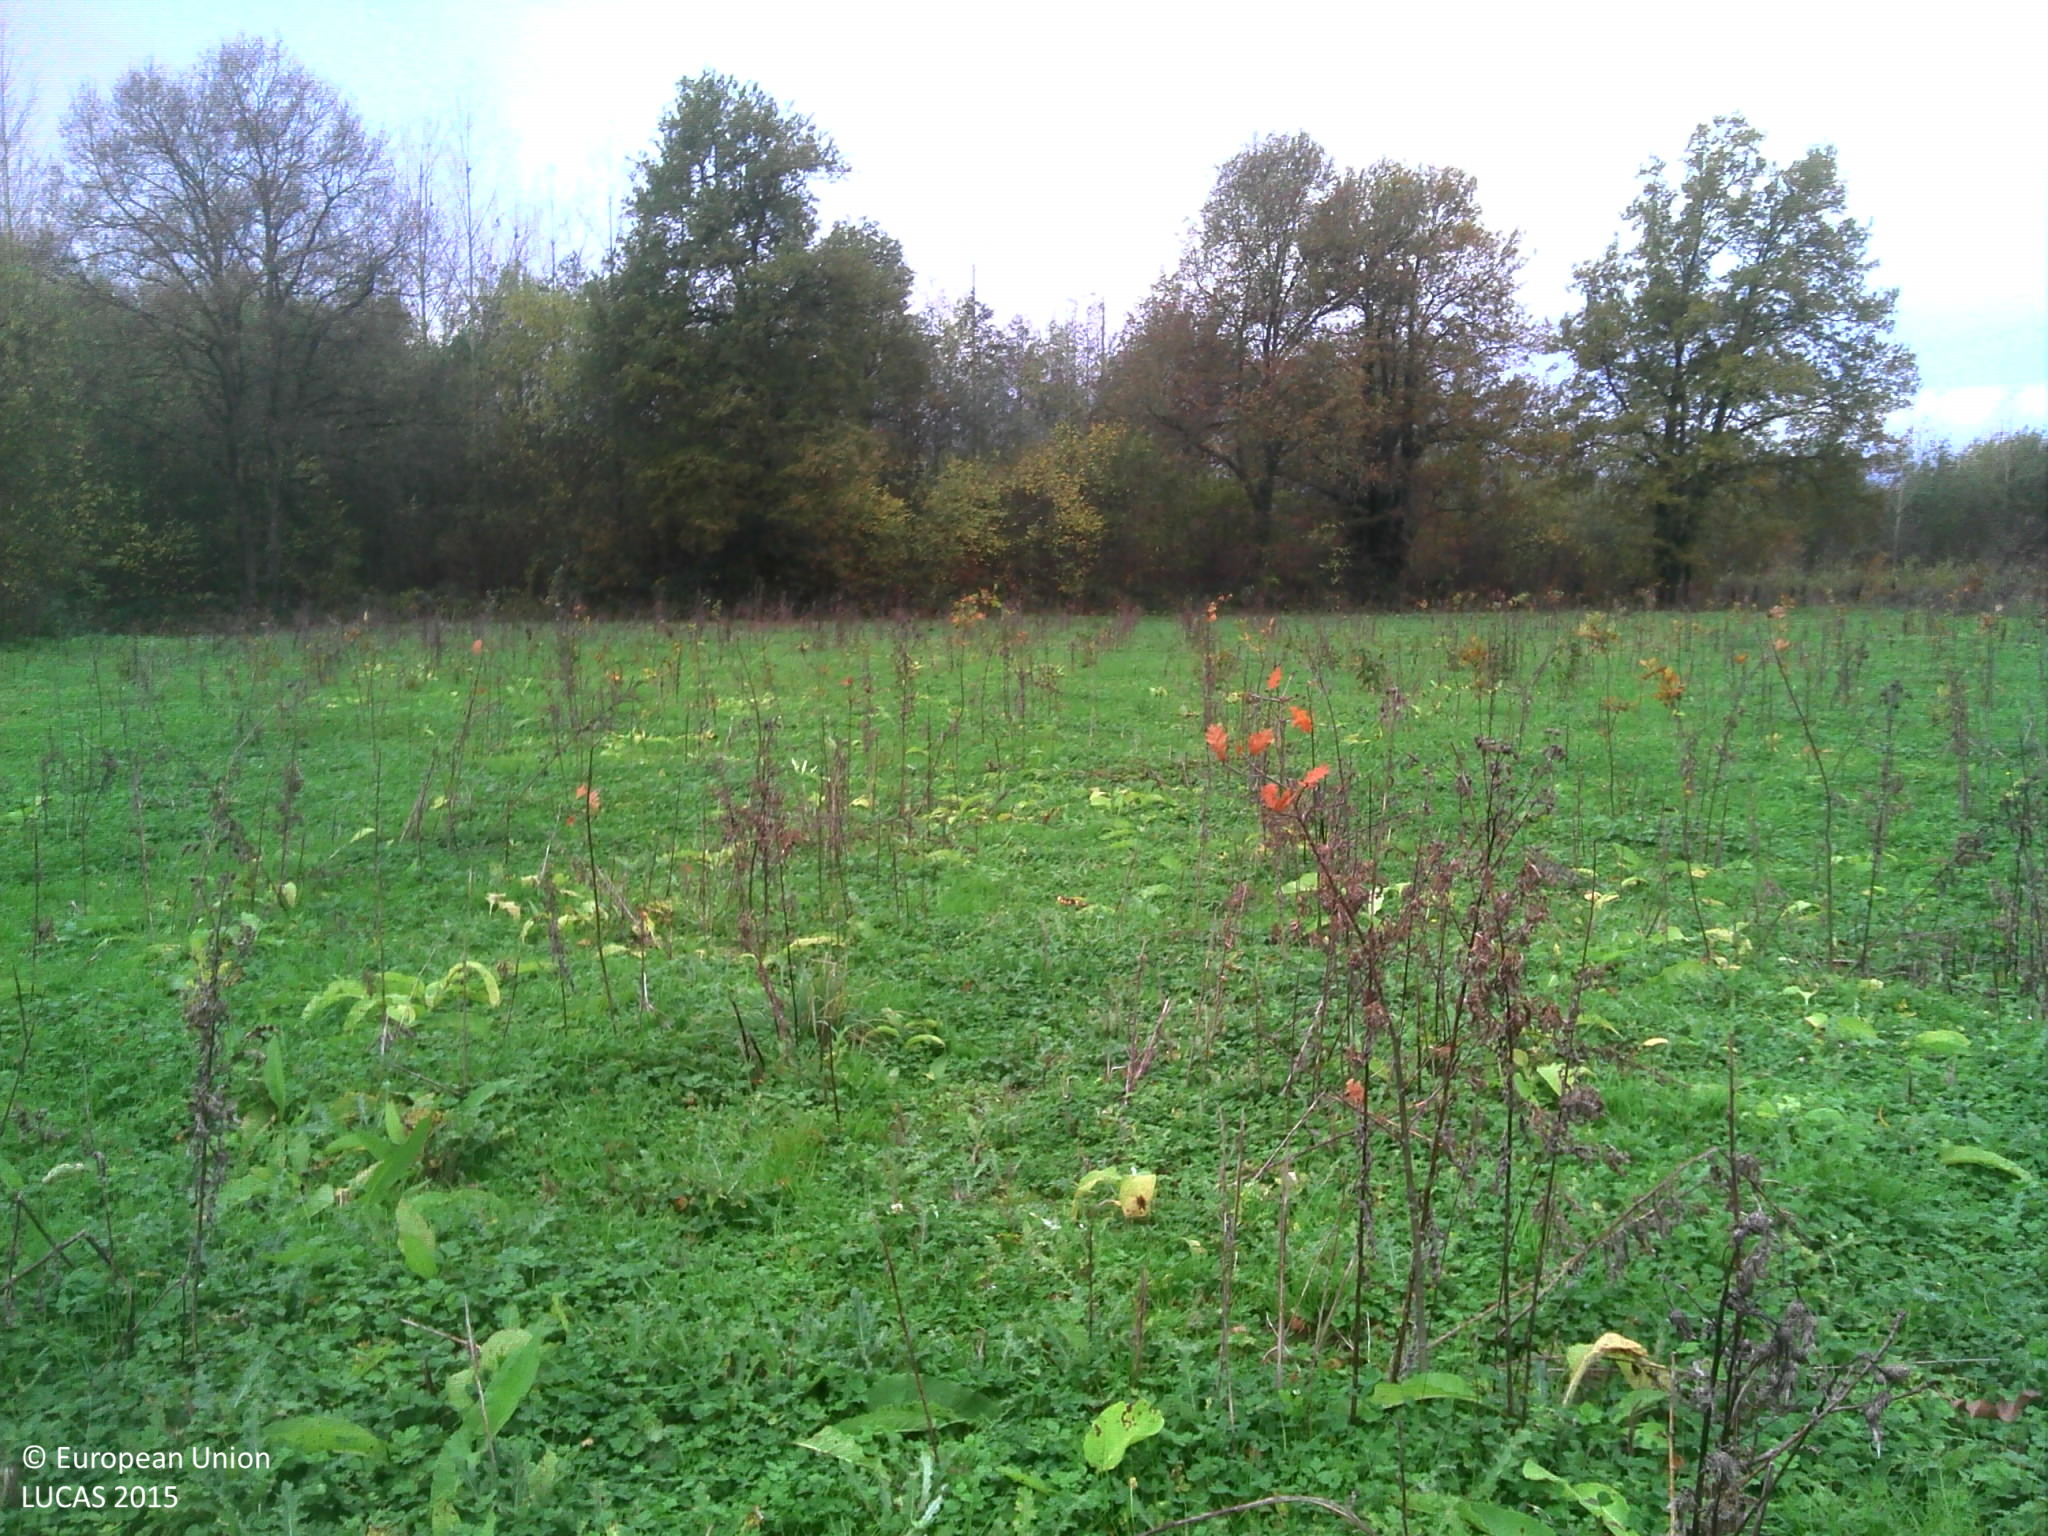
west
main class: Grassland
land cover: Grassland without tree/shrub cover
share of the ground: > 75 %
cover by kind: herbaceous plants 100 %
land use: Agriculture (excluding fallow land and kitchen gardens)
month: November
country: BE
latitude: 50.9613
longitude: 4.6856
